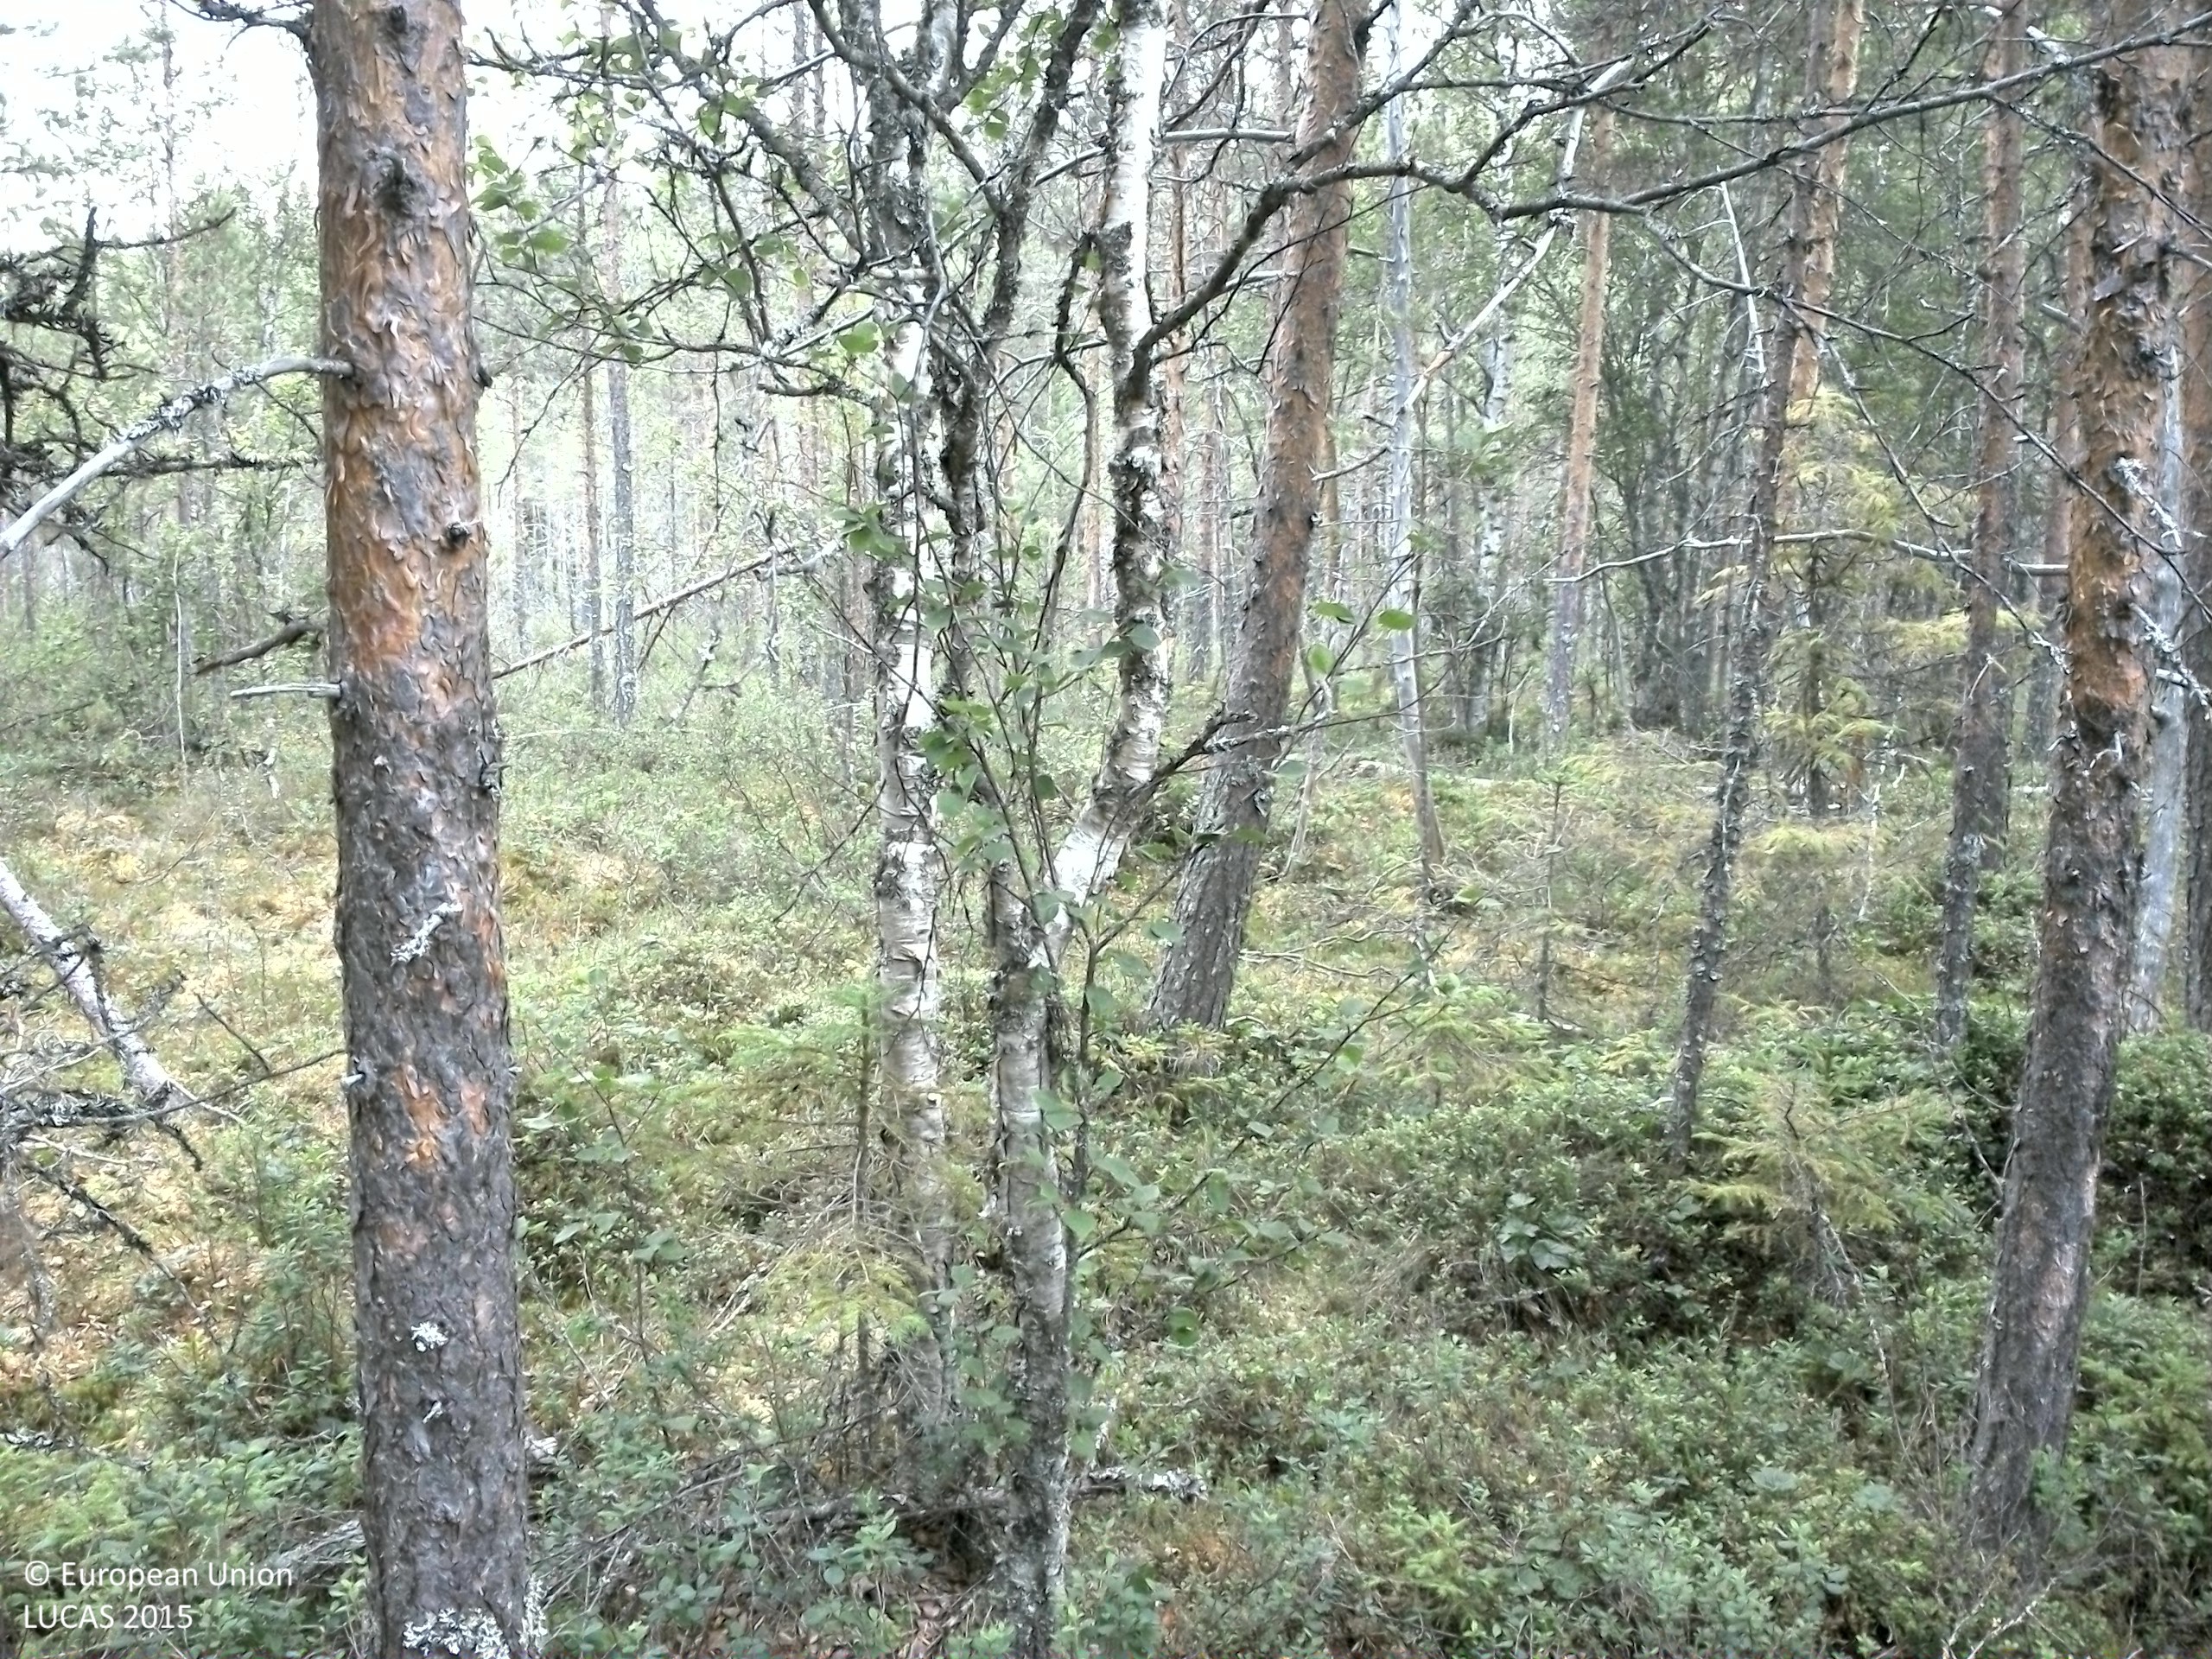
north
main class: Woodland
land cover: Pine dominated mixed woodland
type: boreal forest
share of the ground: 50 - 75 %
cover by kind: coniferous forest trees 35 %, shrubs 25 %, broadleaved forest trees 20 %, lichens and mosses 15 %, herbaceous plants 5 %
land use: Forestry
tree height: > 5 m
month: August
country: SE
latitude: 63.5919
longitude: 16.5631
